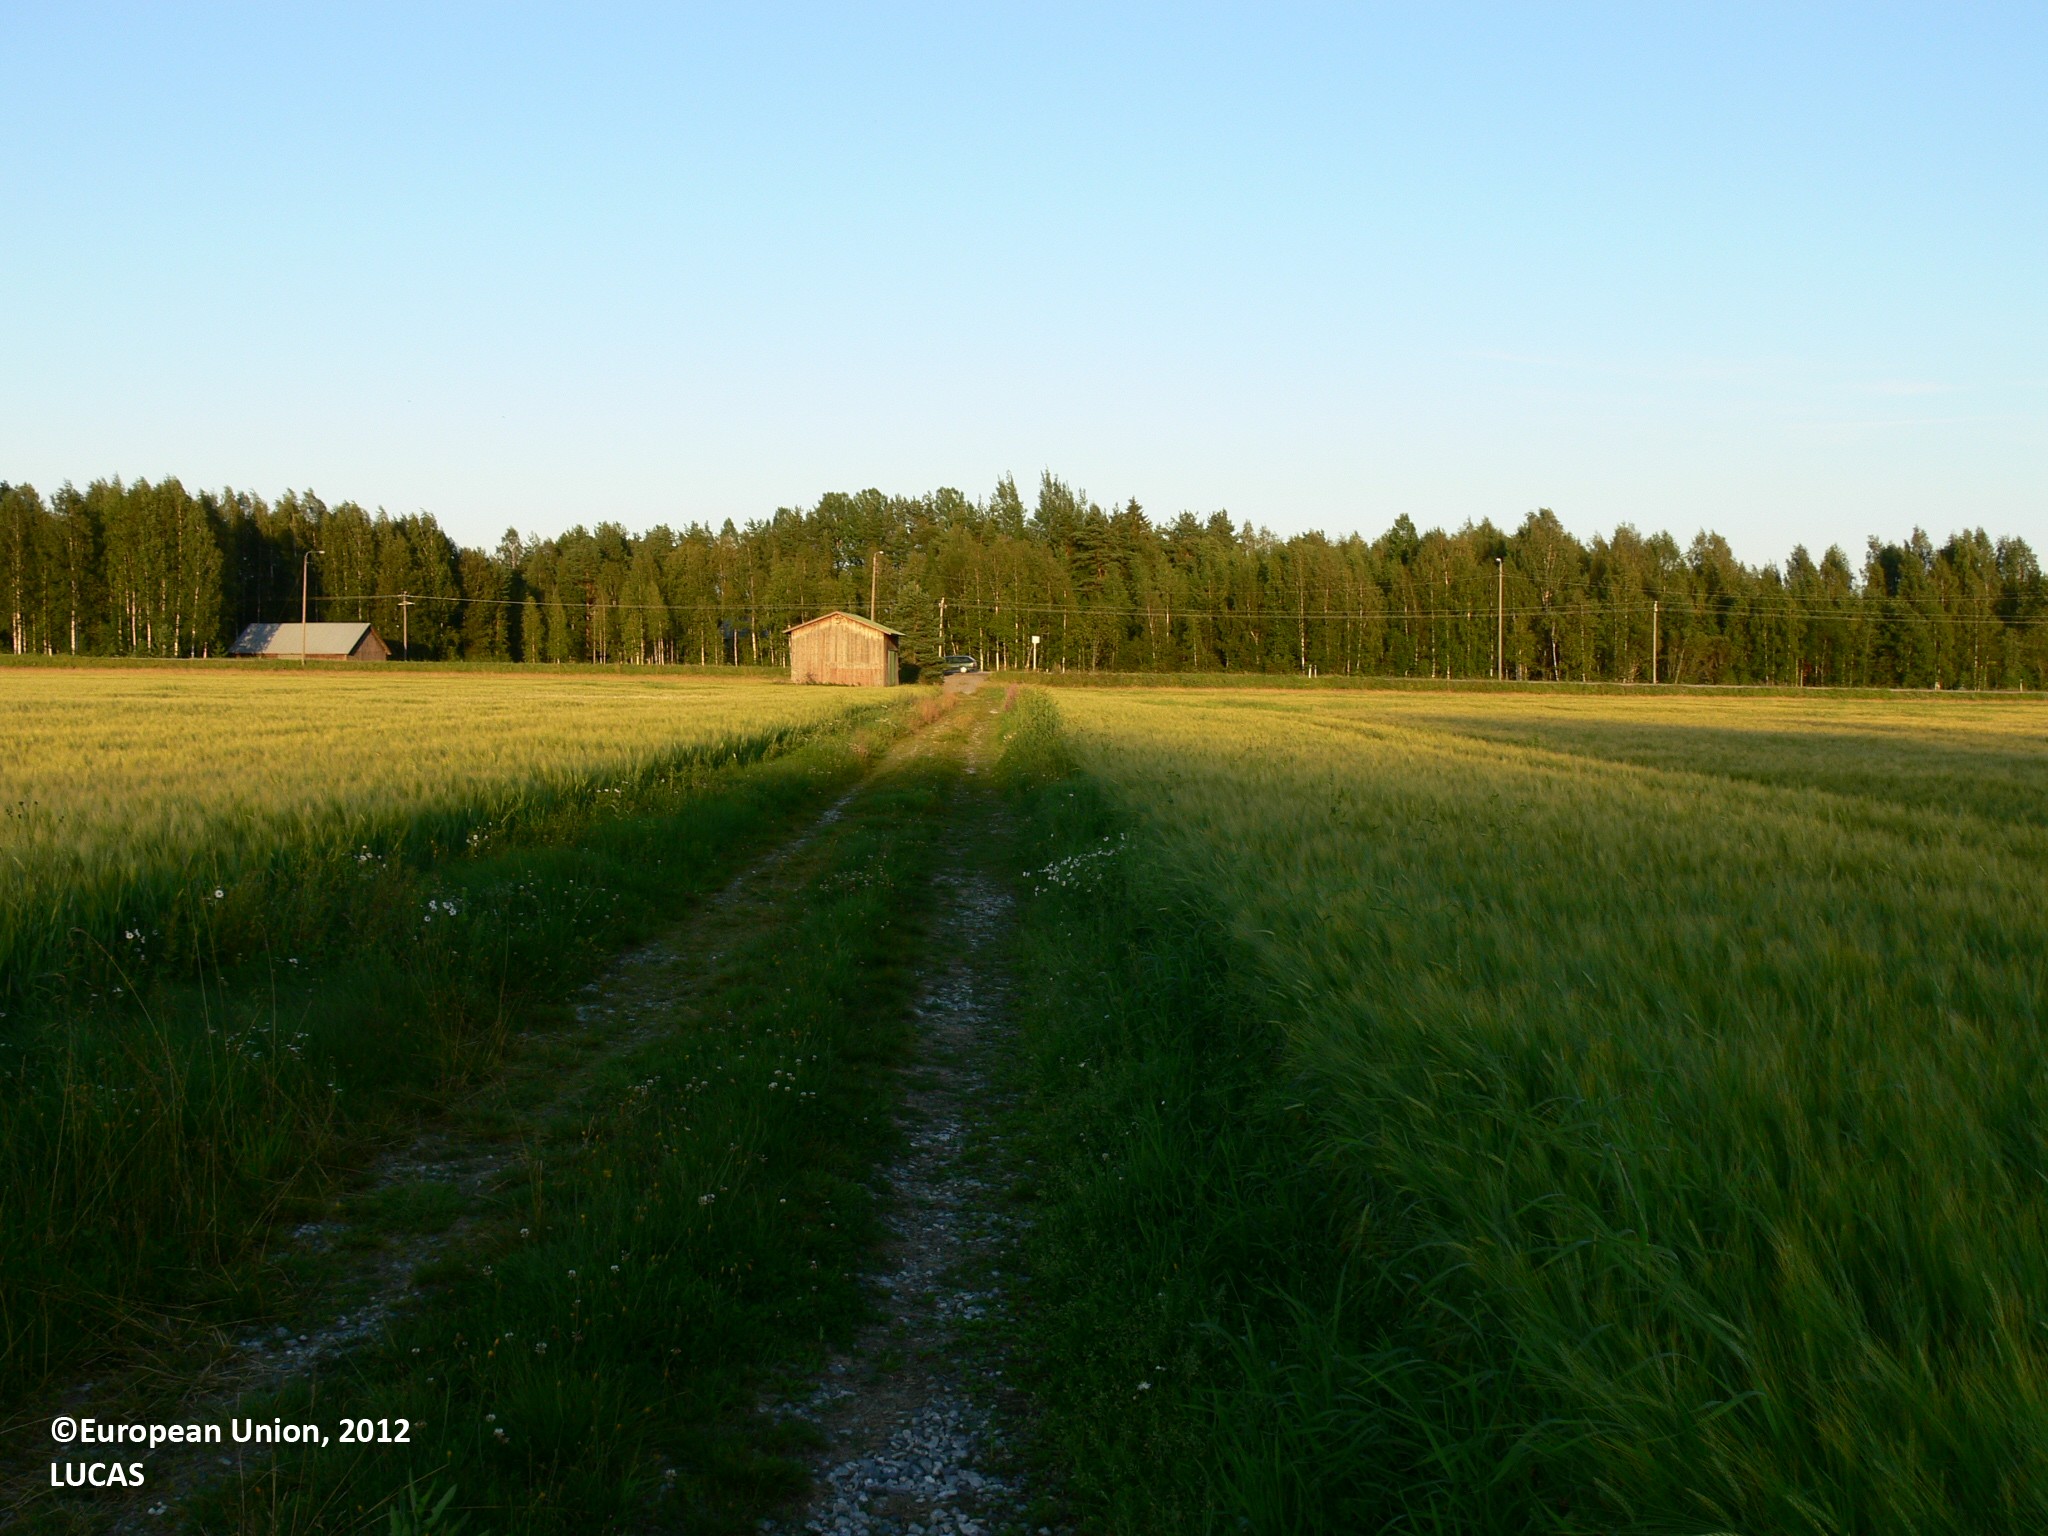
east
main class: Cropland
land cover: Barley
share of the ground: > 75 %
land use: Agriculture (excluding fallow land and kitchen gardens)
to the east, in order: Barley; Grass margins; Tracks; Grass margins; Barley
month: August
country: FI
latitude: 61.9091
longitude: 29.2544
